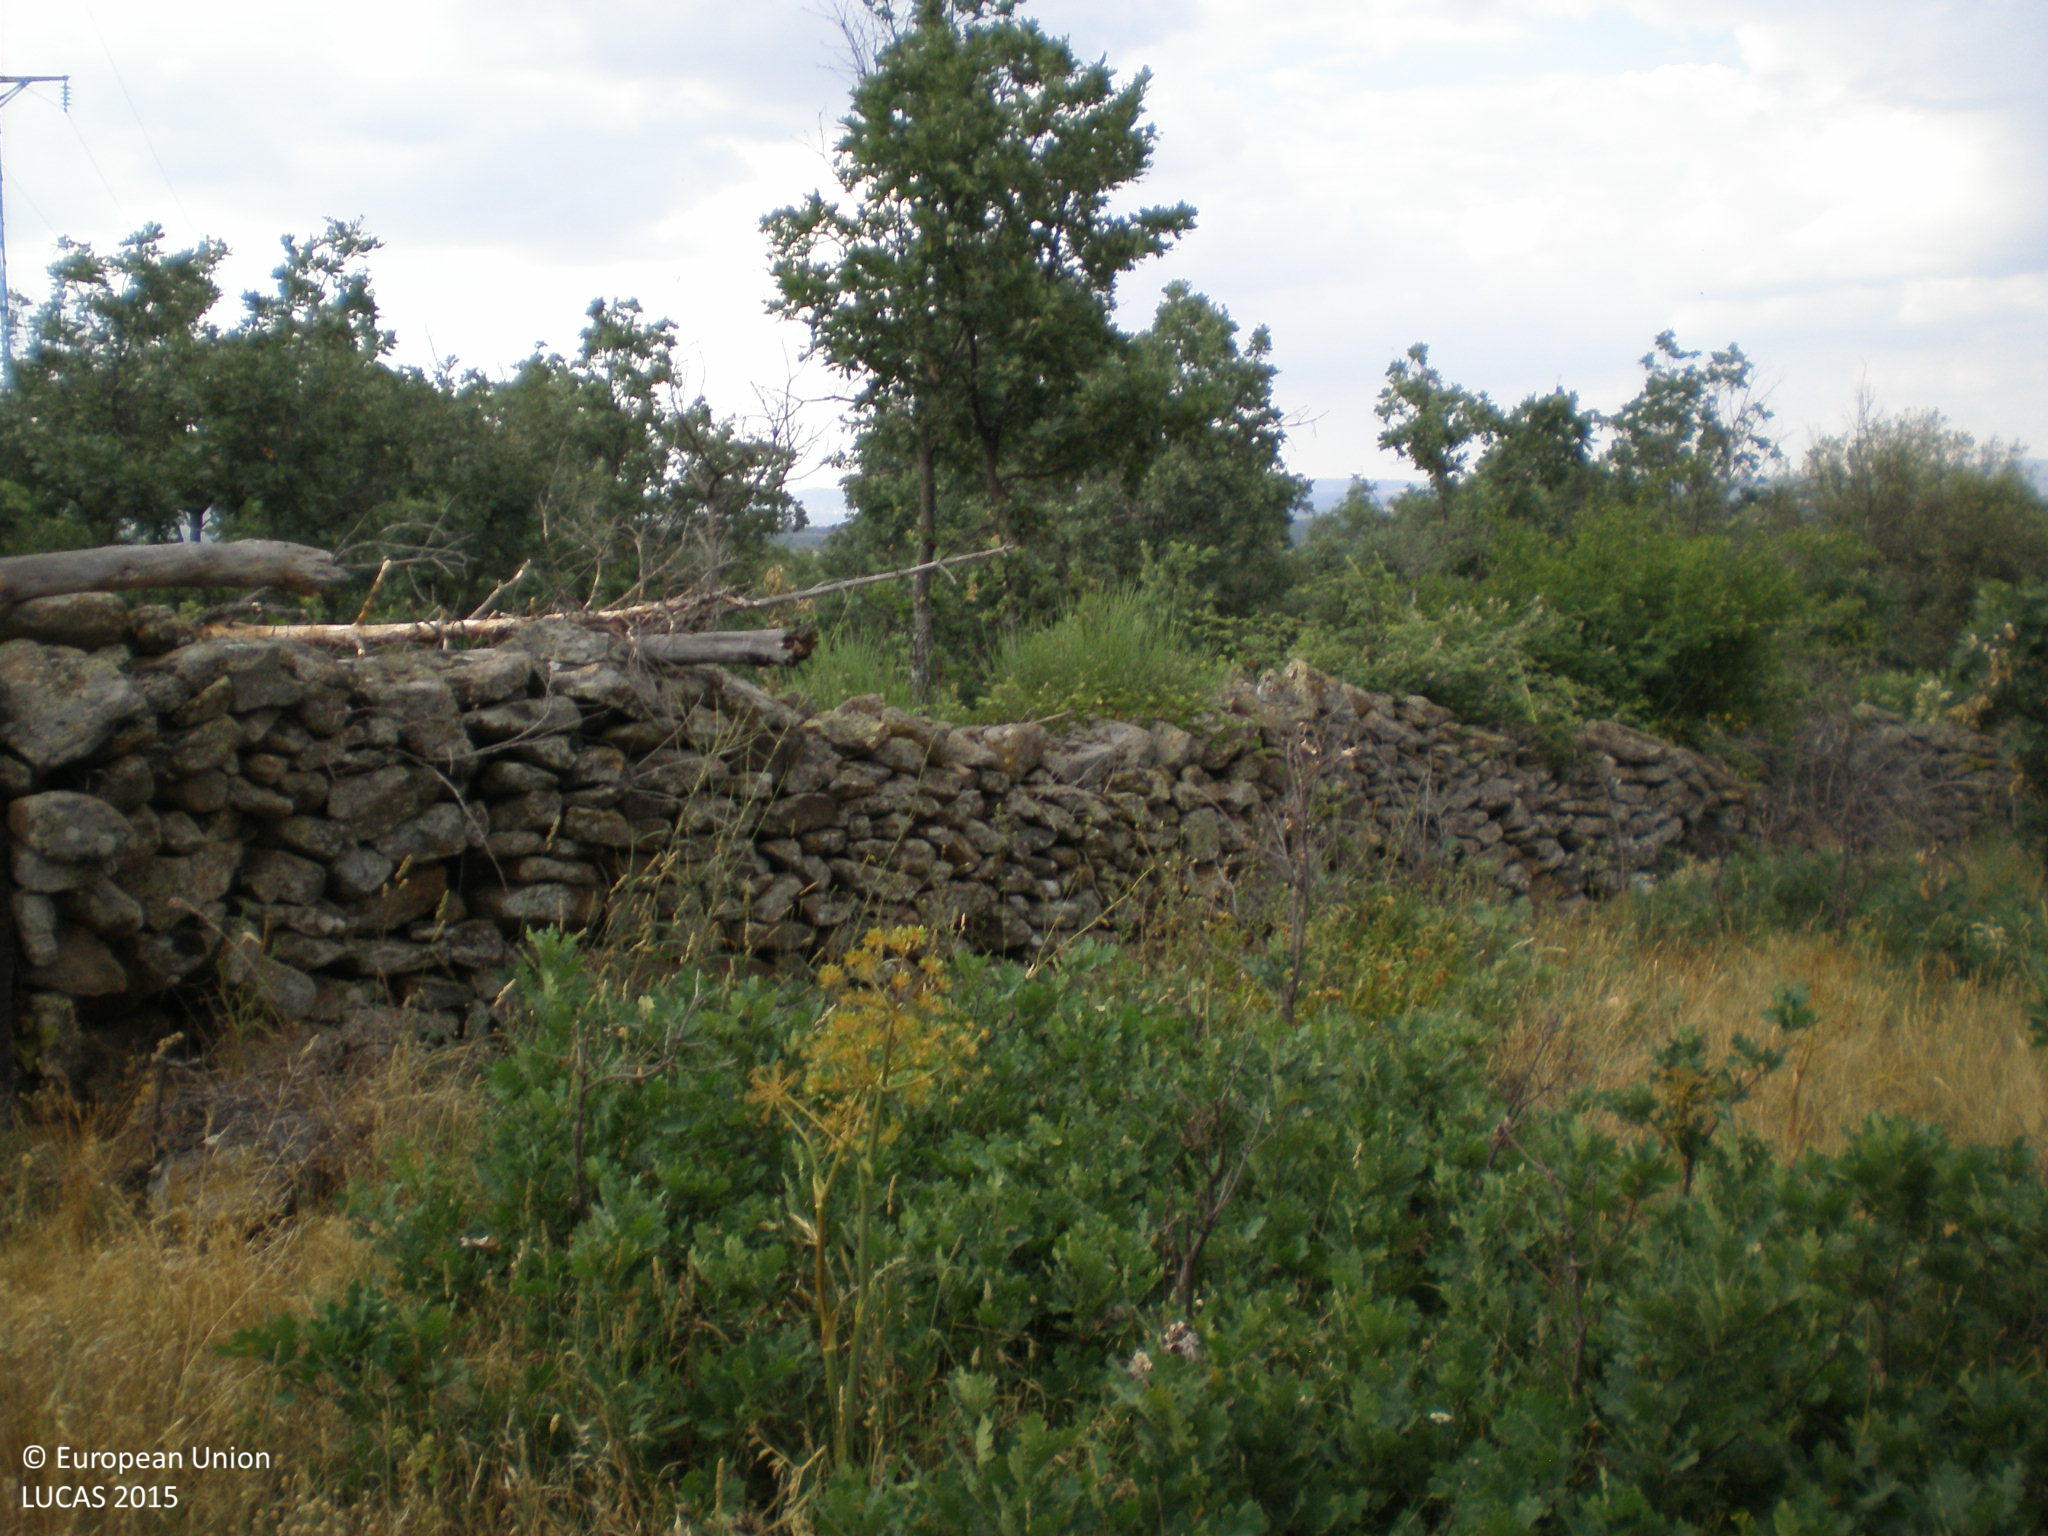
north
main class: Woodland
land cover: Broadleaved woodland
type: thermophilous deciduous forest
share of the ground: 10 - 25 %
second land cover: Grassland without tree/shrub cover
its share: > 75 %
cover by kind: herbaceous plants 85 %, broadleaved forest trees 15 %
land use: Forestry
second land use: Agriculture (excluding fallow land and kitchen gardens)
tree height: > 5 m
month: June
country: ES
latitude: 40.3821
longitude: -5.5322
